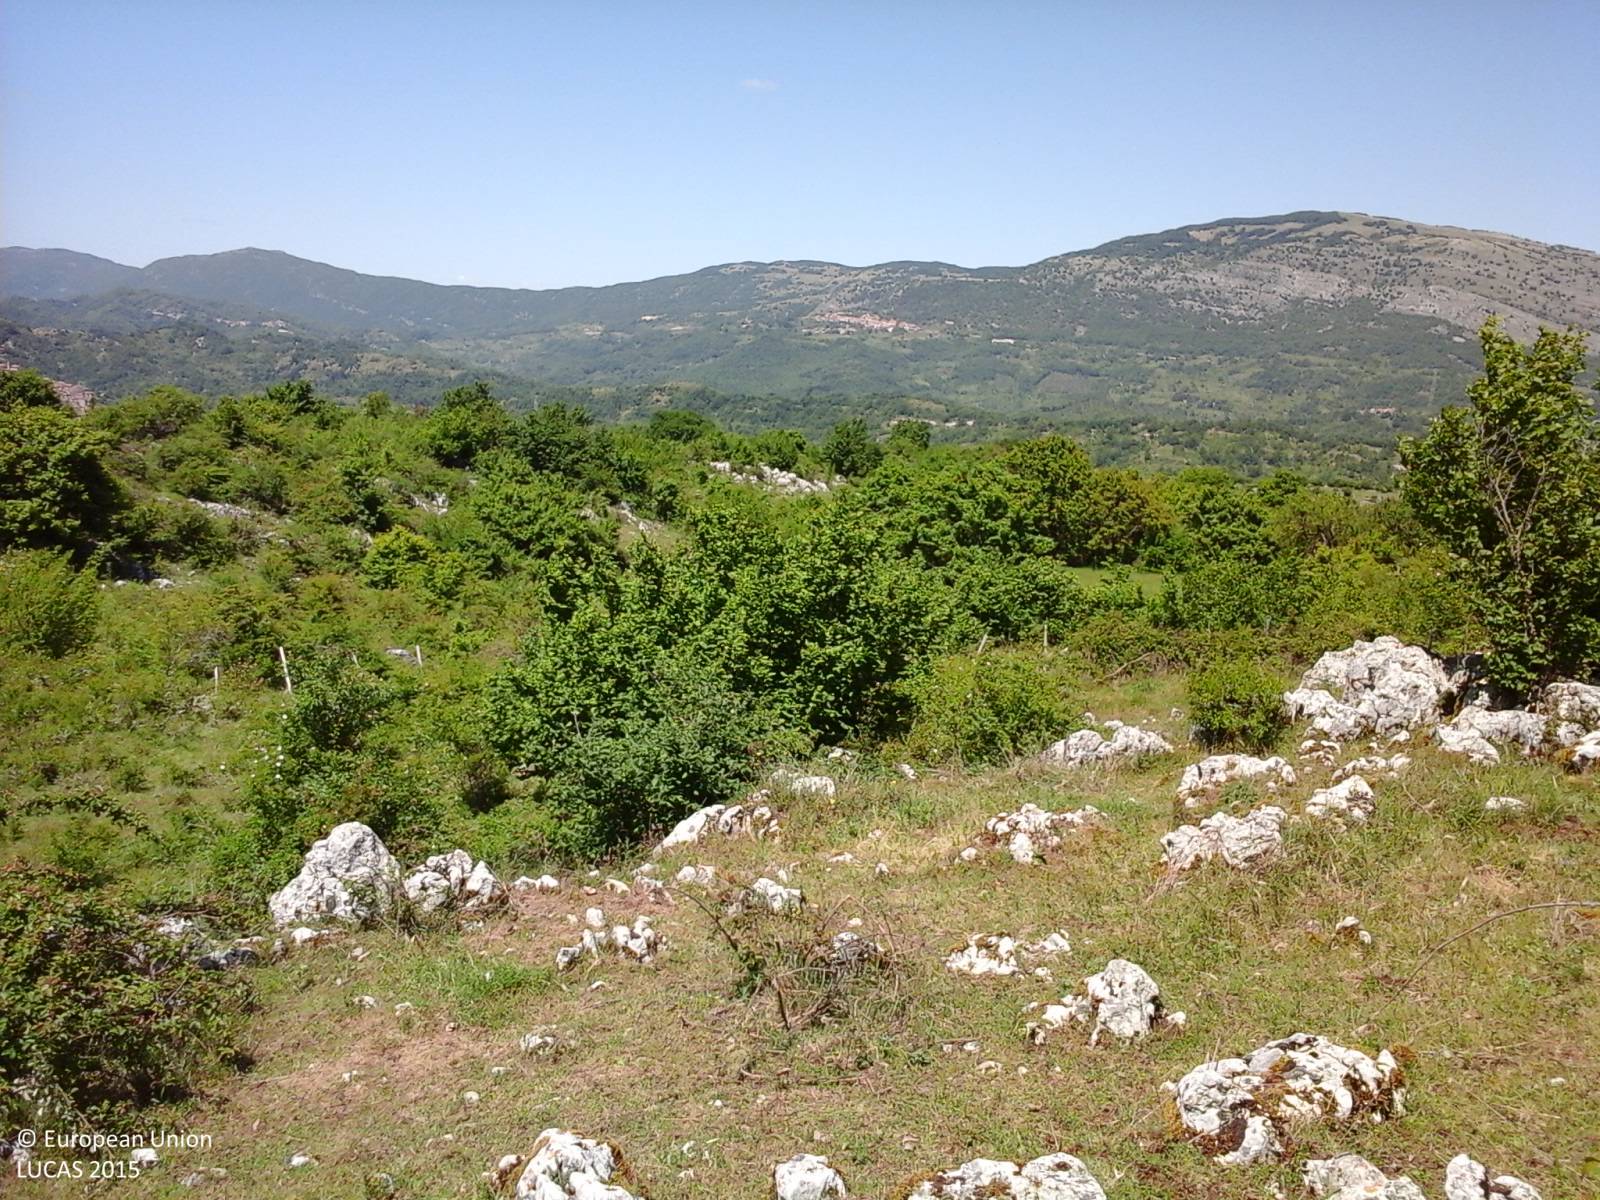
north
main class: Cropland
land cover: Lucerne
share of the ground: > 75 %
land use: Agriculture (excluding fallow land and kitchen gardens)
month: May
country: IT
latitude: 42.0787
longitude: 13.2163
